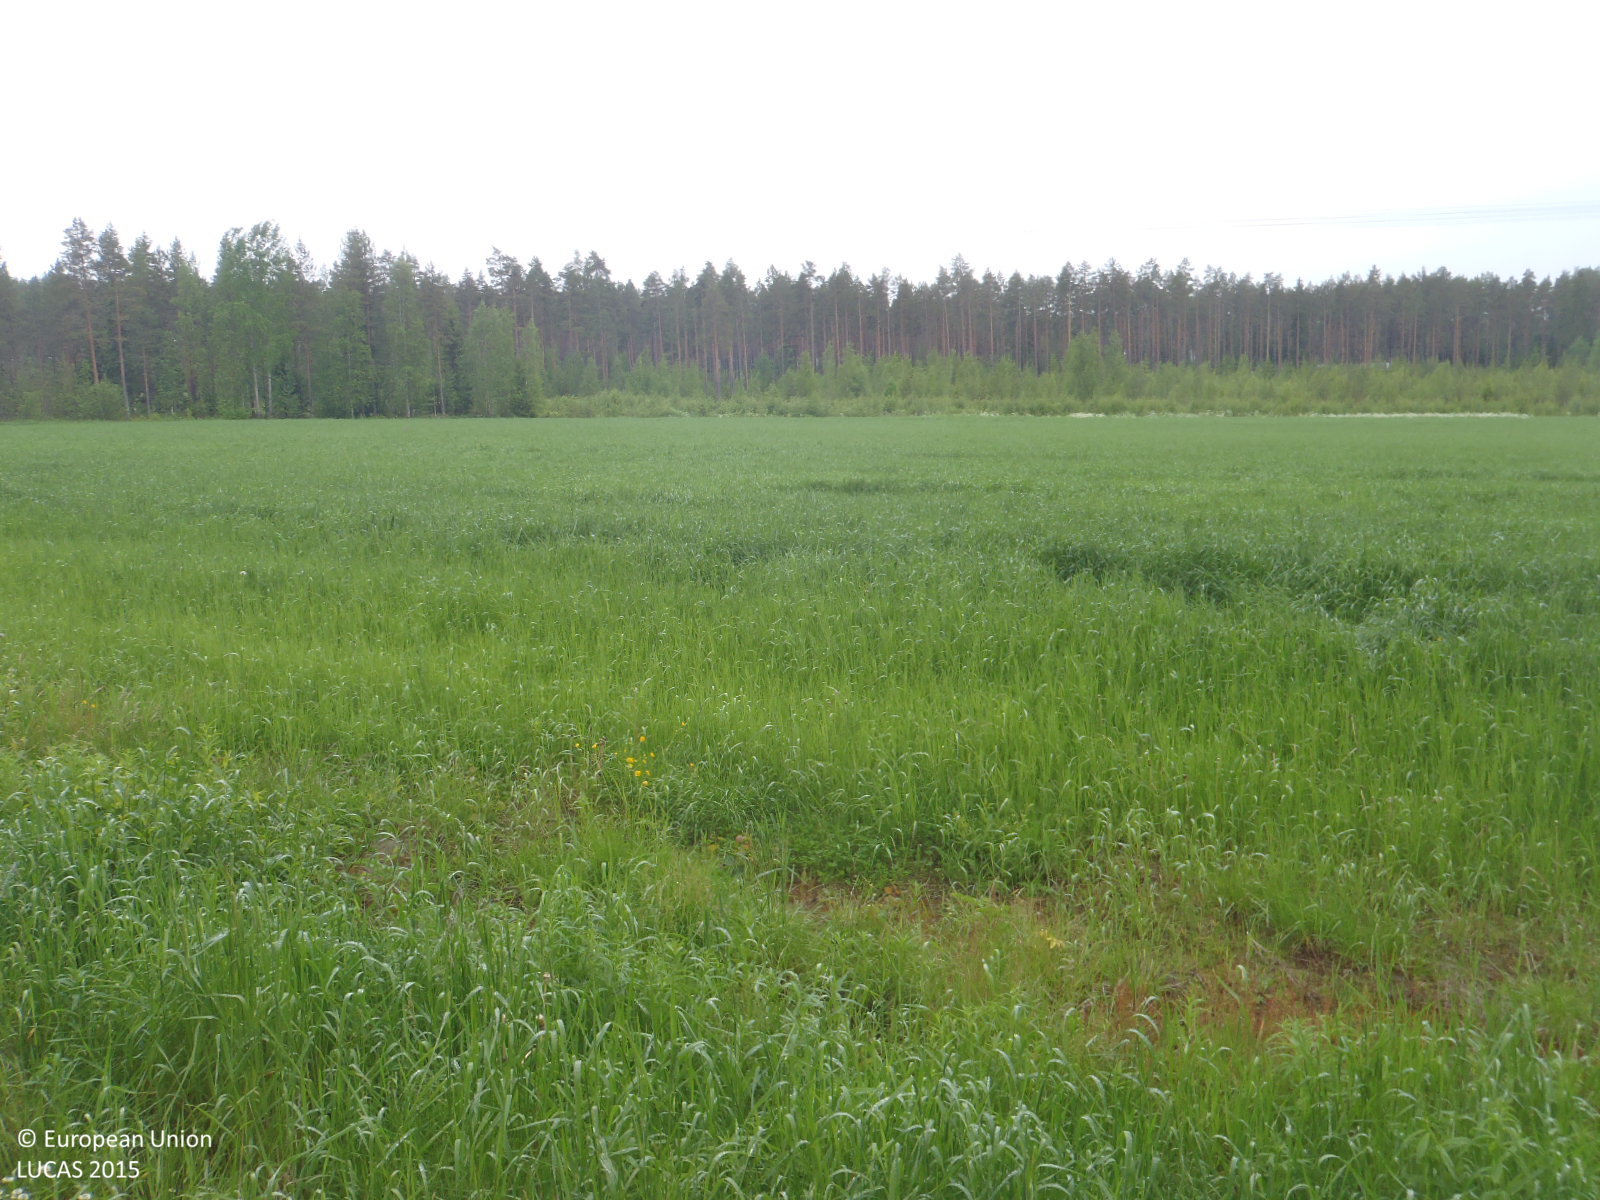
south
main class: Cropland
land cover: Temporary grasslands
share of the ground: > 75 %
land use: Agriculture (excluding fallow land and kitchen gardens)
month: June
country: FI
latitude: 64.9095
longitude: 25.8385
